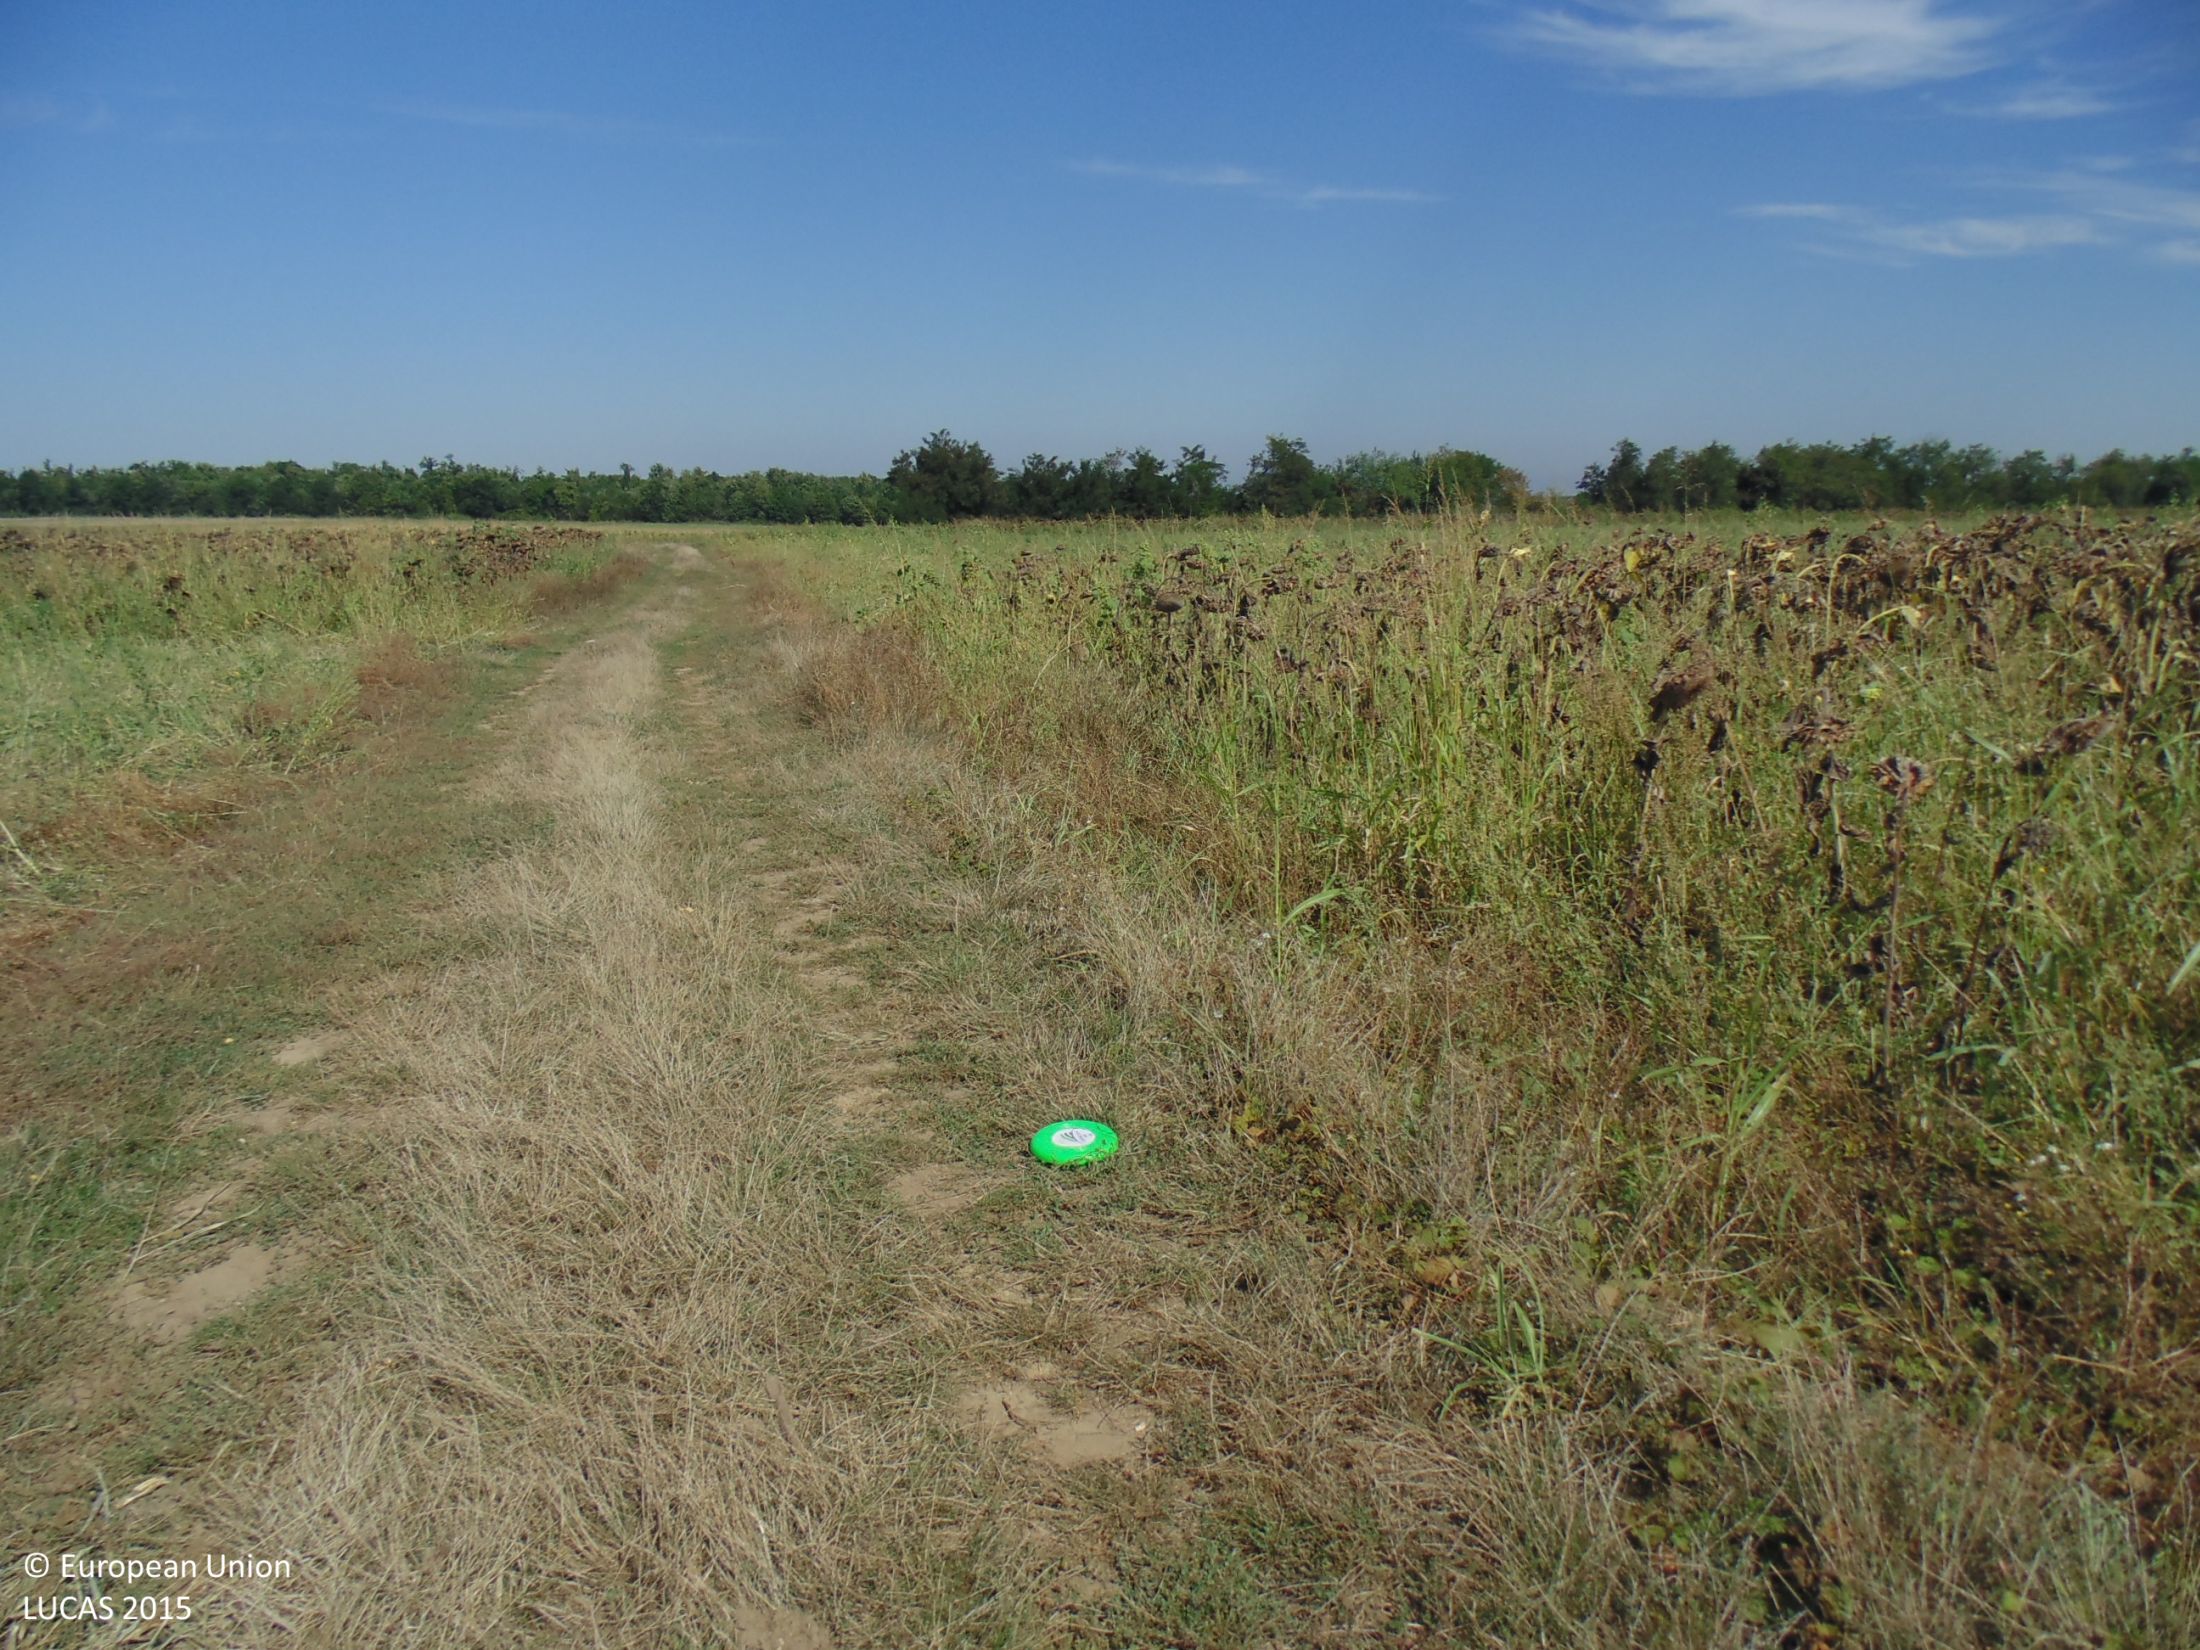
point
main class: Cropland
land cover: Sunflower
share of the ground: > 75 %
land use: Agriculture (excluding fallow land and kitchen gardens)
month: September
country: BG
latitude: 43.8909
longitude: 27.1168
